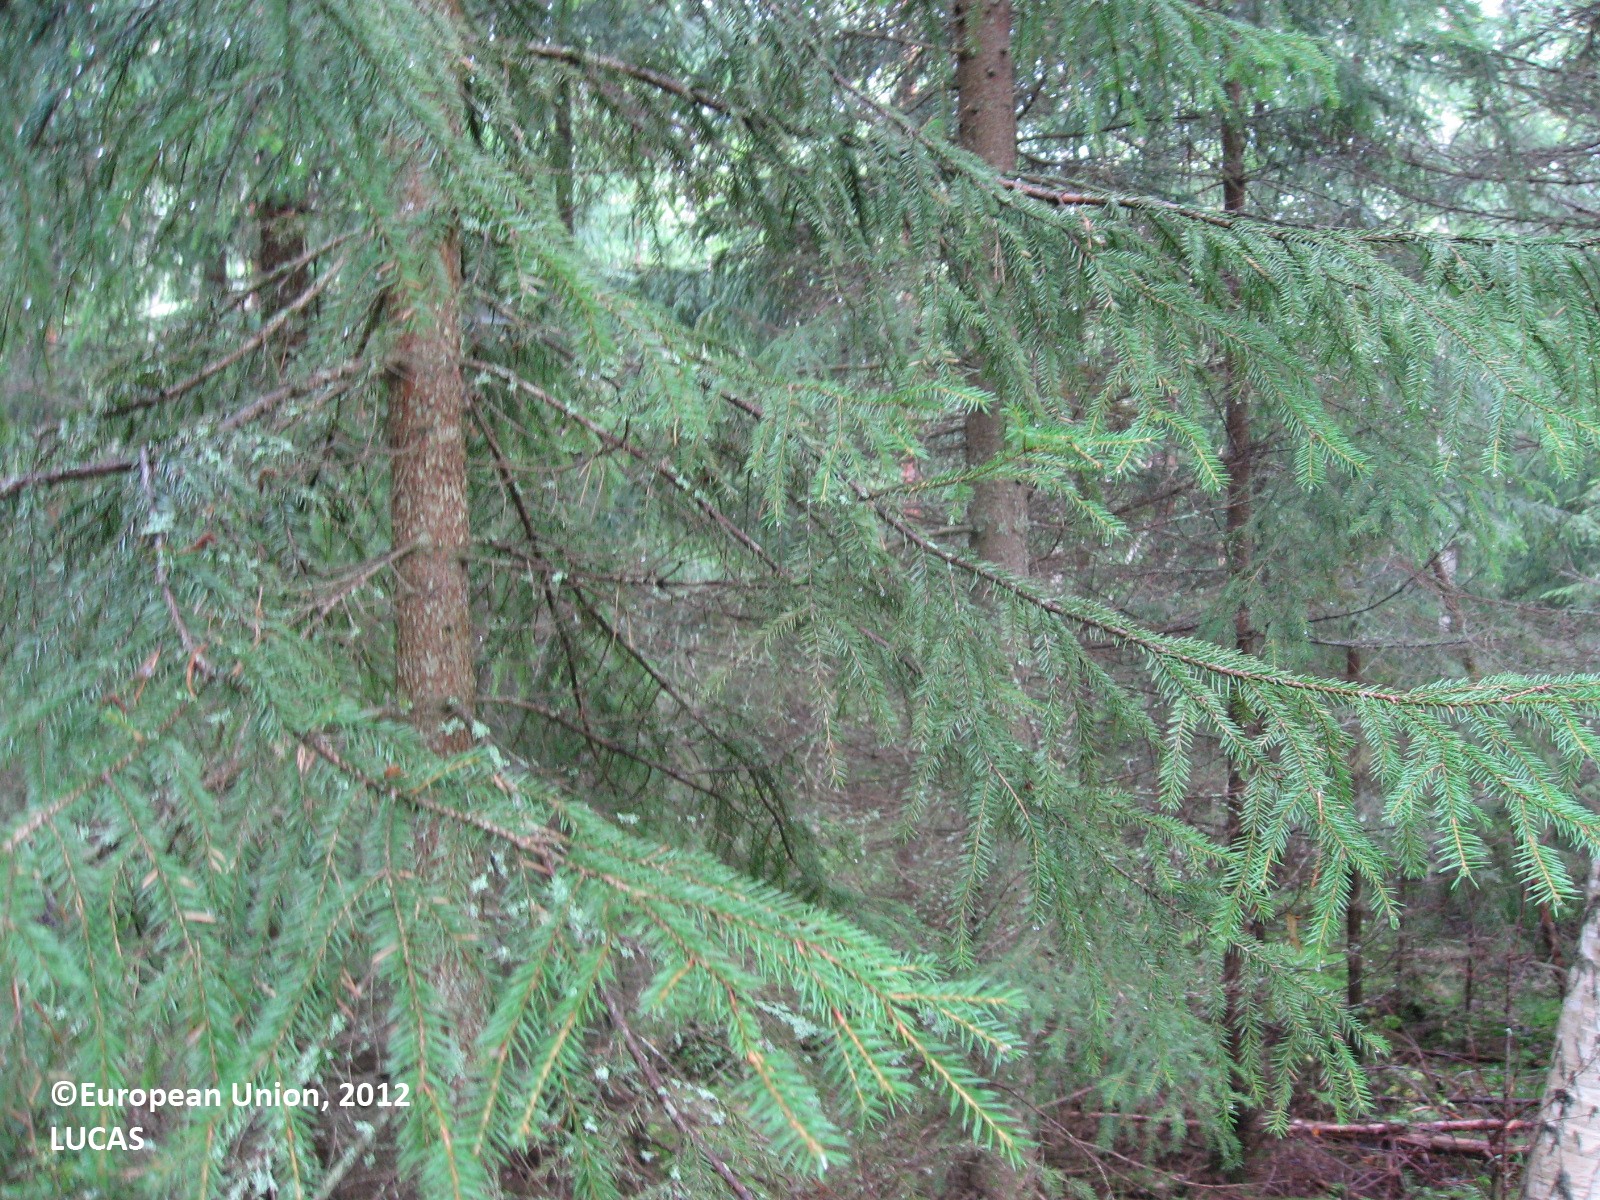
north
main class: Woodland
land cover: Pine dominated mixed woodland
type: boreal forest
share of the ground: 50 - 75 %
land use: Forestry
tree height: > 5 m
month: August
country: FI
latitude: 60.6305
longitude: 25.0890
